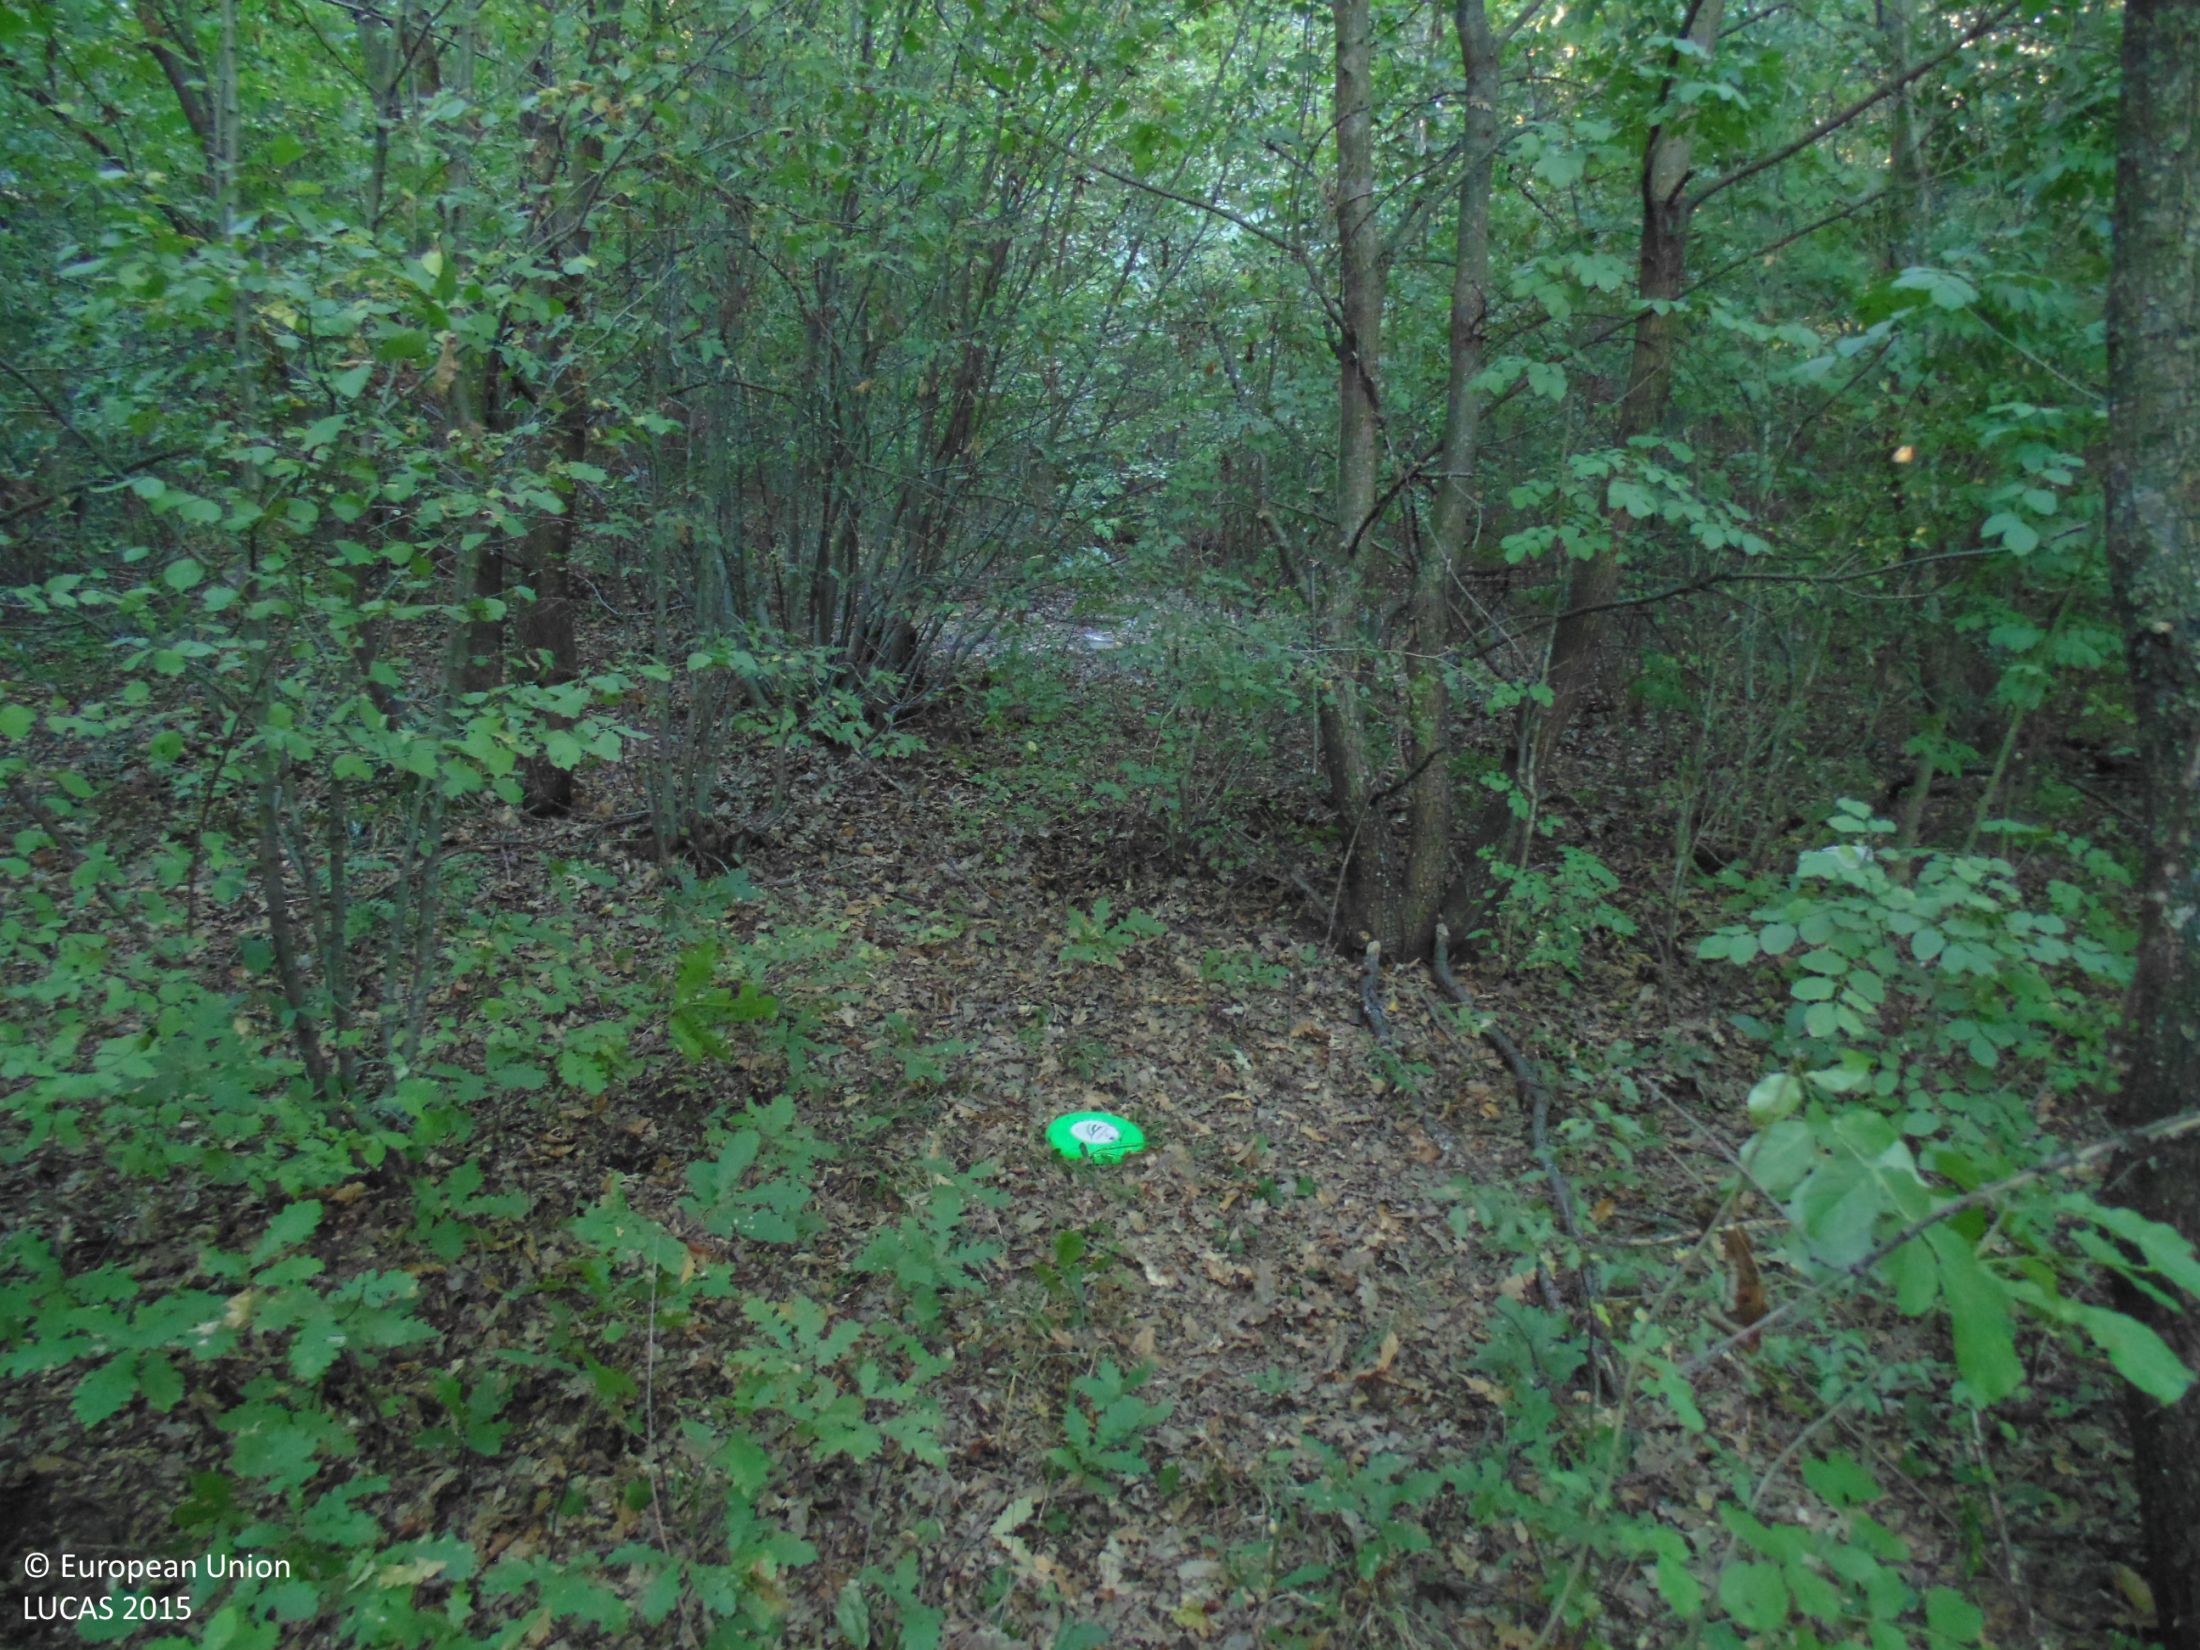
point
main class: Woodland
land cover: Broadleaved woodland
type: mesophytic deciduous forest
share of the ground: > 75 %
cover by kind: broadleaved forest trees 90 %, shrubs 10 %
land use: Forestry
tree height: > 5 m
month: September
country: BG
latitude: 43.8291
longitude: 27.0469
